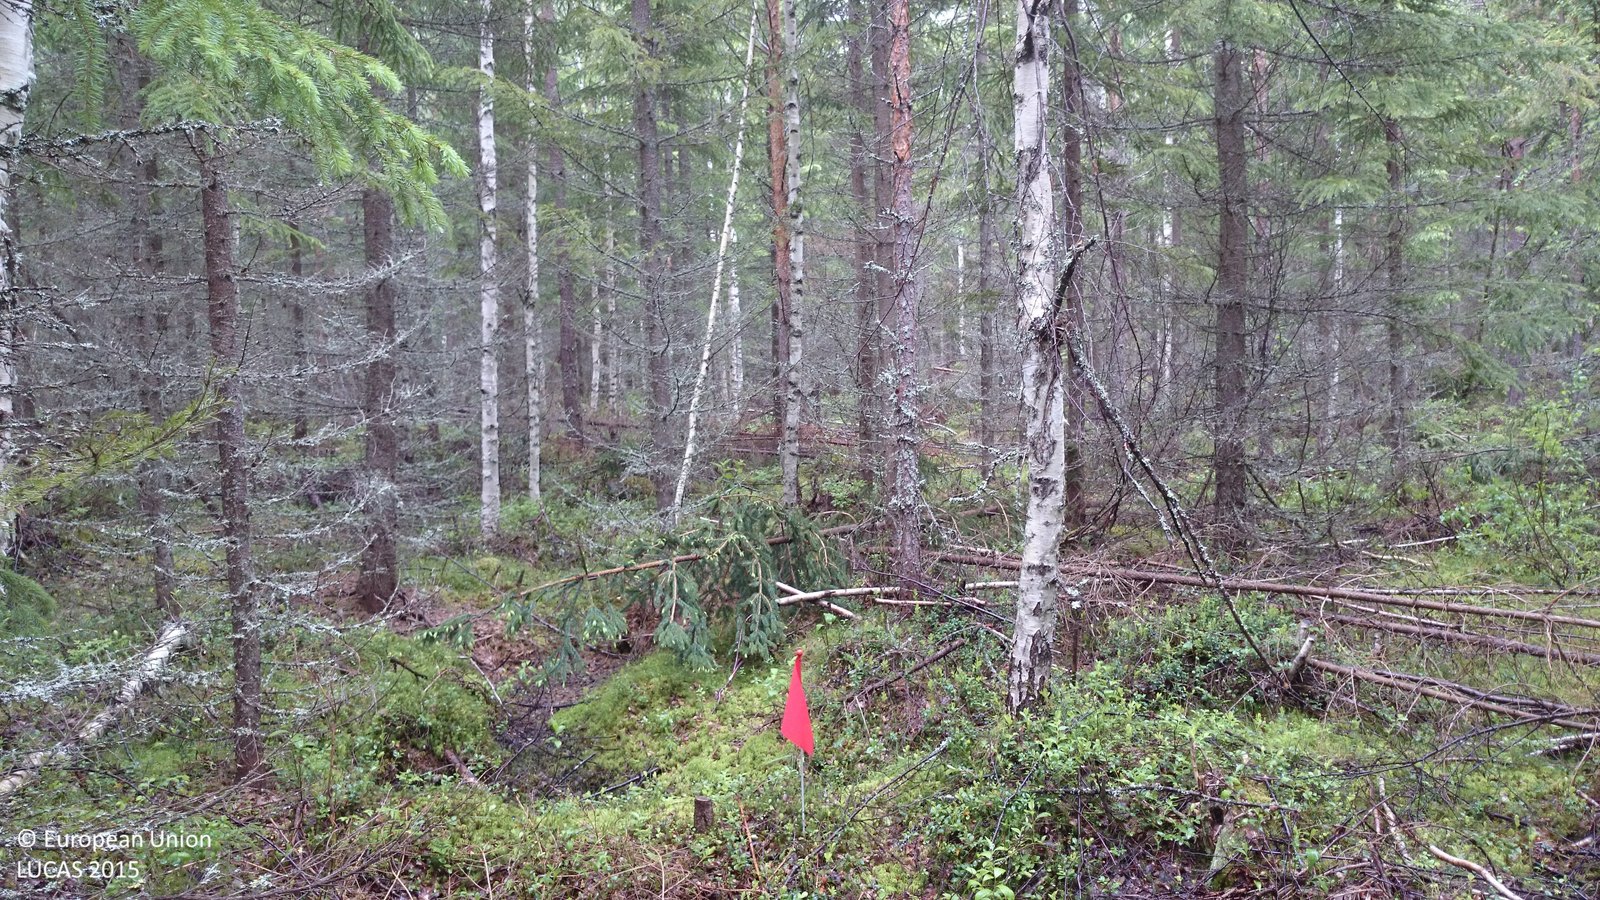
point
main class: Woodland
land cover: Spruce dominated mixed woodland
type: boreal forest
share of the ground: 25 - 50 %
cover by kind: lichens and mosses 35 %, coniferous forest trees 30 %, shrubs 20 %, broadleaved forest trees 15 %
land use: Forestry
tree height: > 5 m
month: June
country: SE
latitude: 61.9883
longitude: 16.7959
